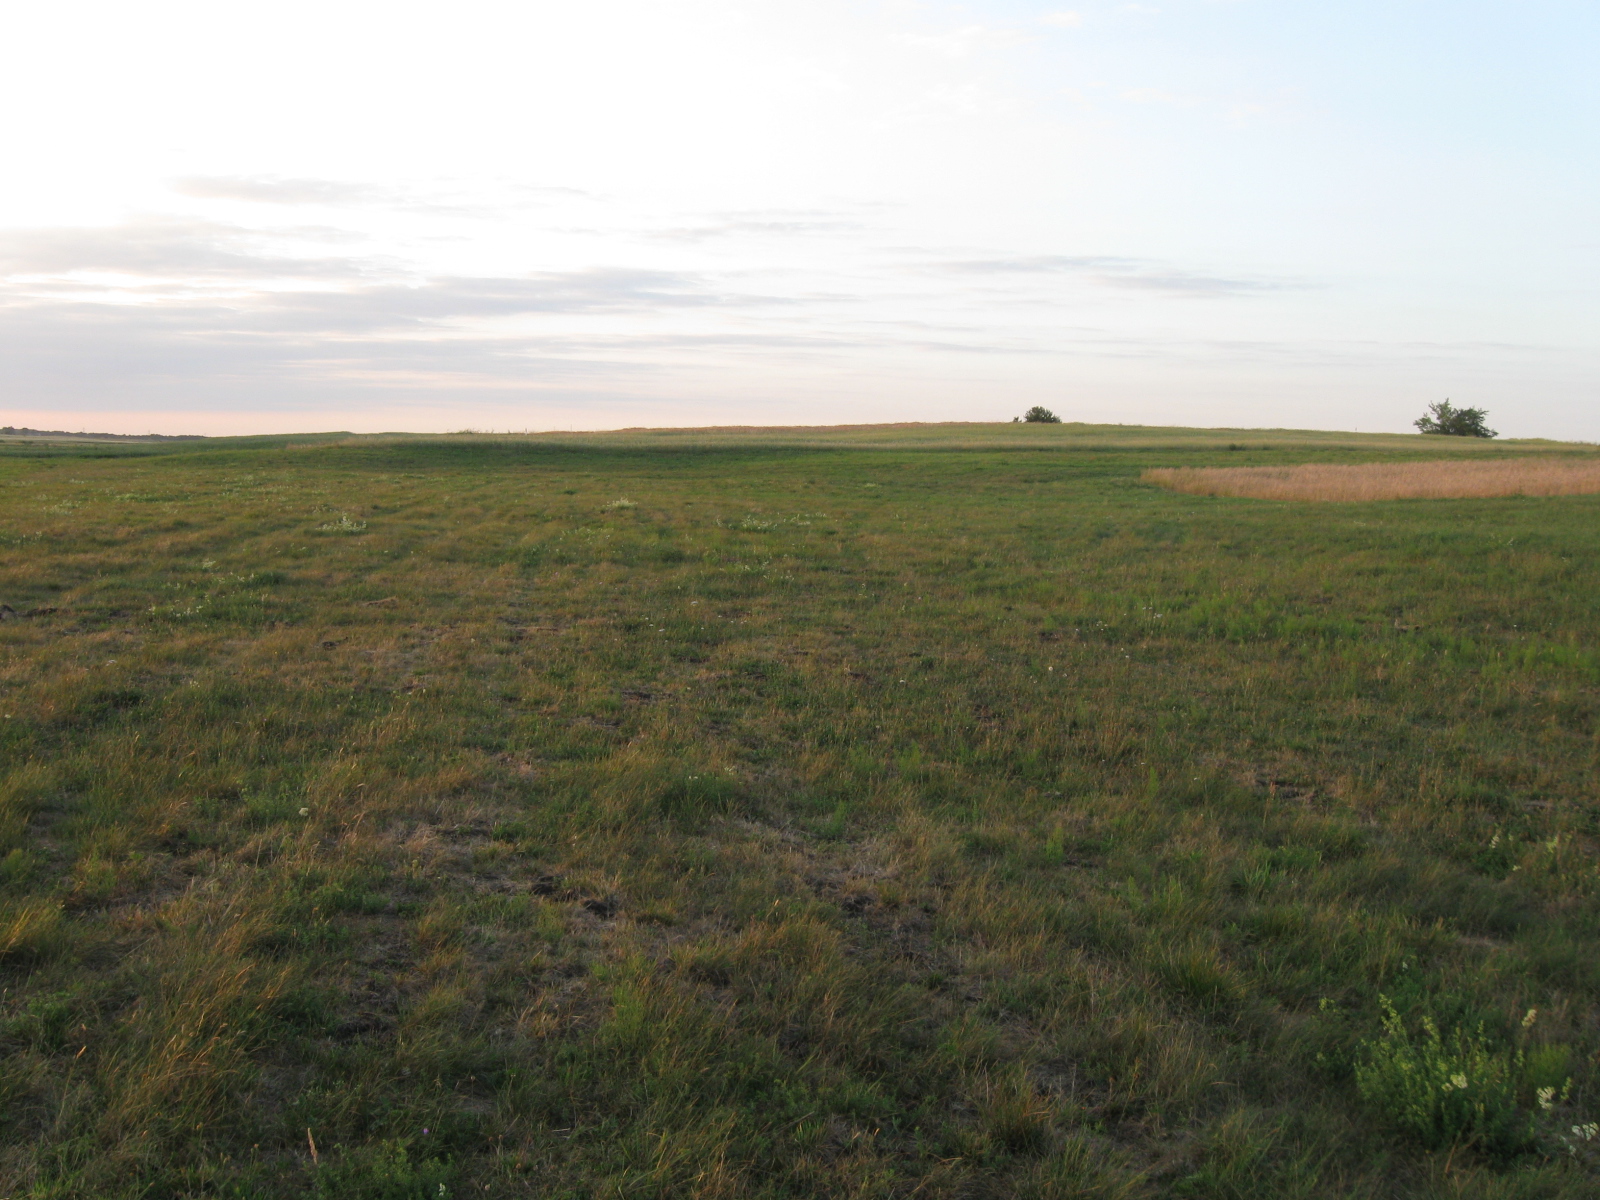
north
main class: Grassland
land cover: Grassland without tree/shrub cover
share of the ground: > 75 %
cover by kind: herbaceous plants 90 %, unconsolidated bare surface 10 %
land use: Agriculture (excluding fallow land and kitchen gardens)
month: July
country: LT
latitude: 54.2634
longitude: 23.5164
